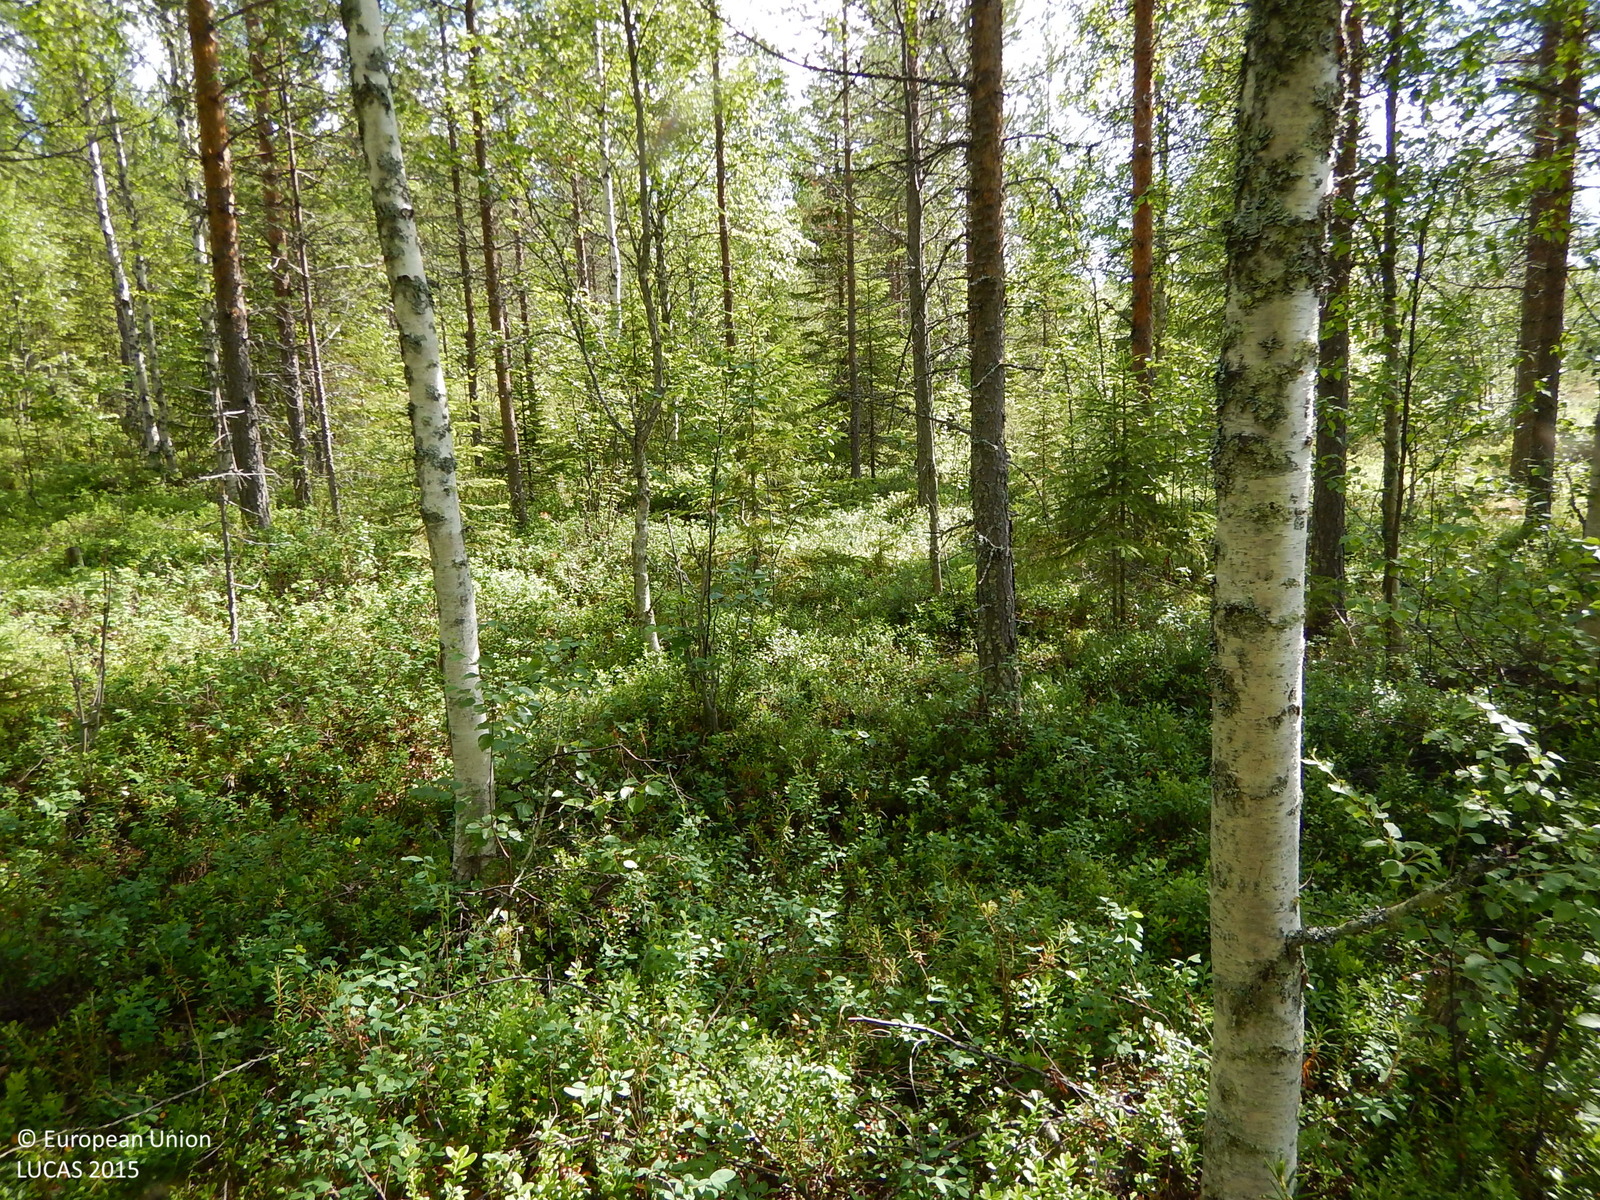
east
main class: Woodland
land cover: Broadleaved woodland
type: boreal forest
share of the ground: 25 - 50 %
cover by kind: broadleaved forest trees 45 %, shrubs 30 %, herbaceous plants 10 %, lichens and mosses 10 %, coniferous forest trees 5 %
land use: Forestry
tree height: > 5 m
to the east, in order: Broadleaved woodland; Pine dominated mixed woodland; Other mixed woodland
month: July
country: SE
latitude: 65.0142
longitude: 19.9627
